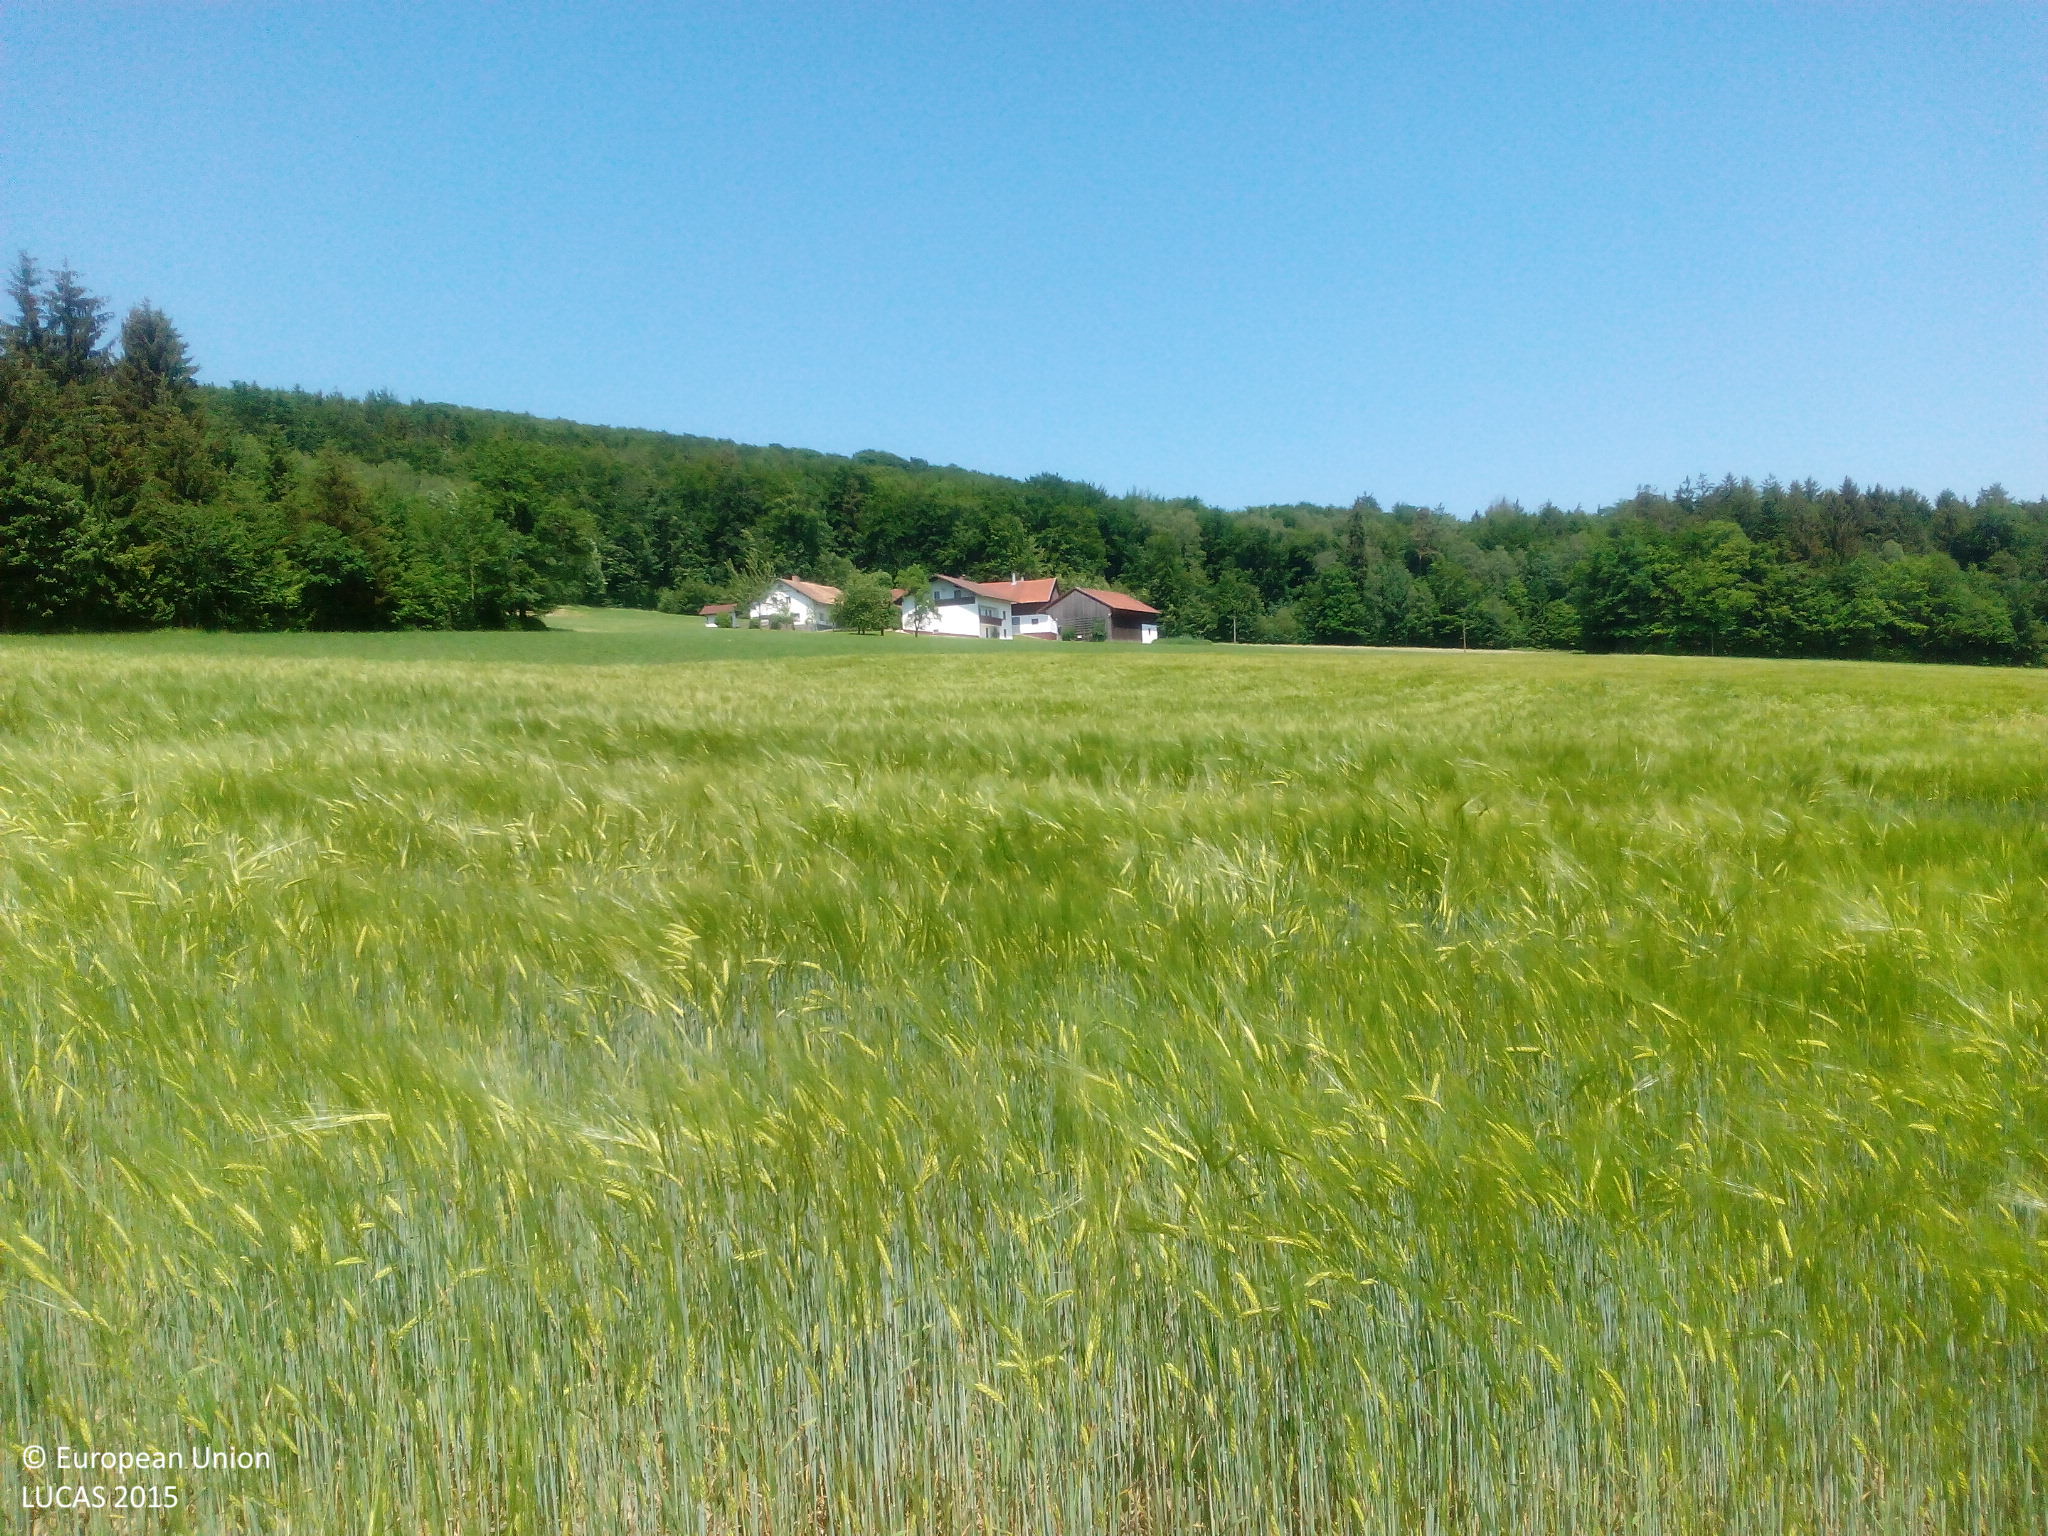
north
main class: Cropland
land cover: Barley
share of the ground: > 75 %
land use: Agriculture (excluding fallow land and kitchen gardens)
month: June
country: DE
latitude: 49.3202
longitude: 12.8750
